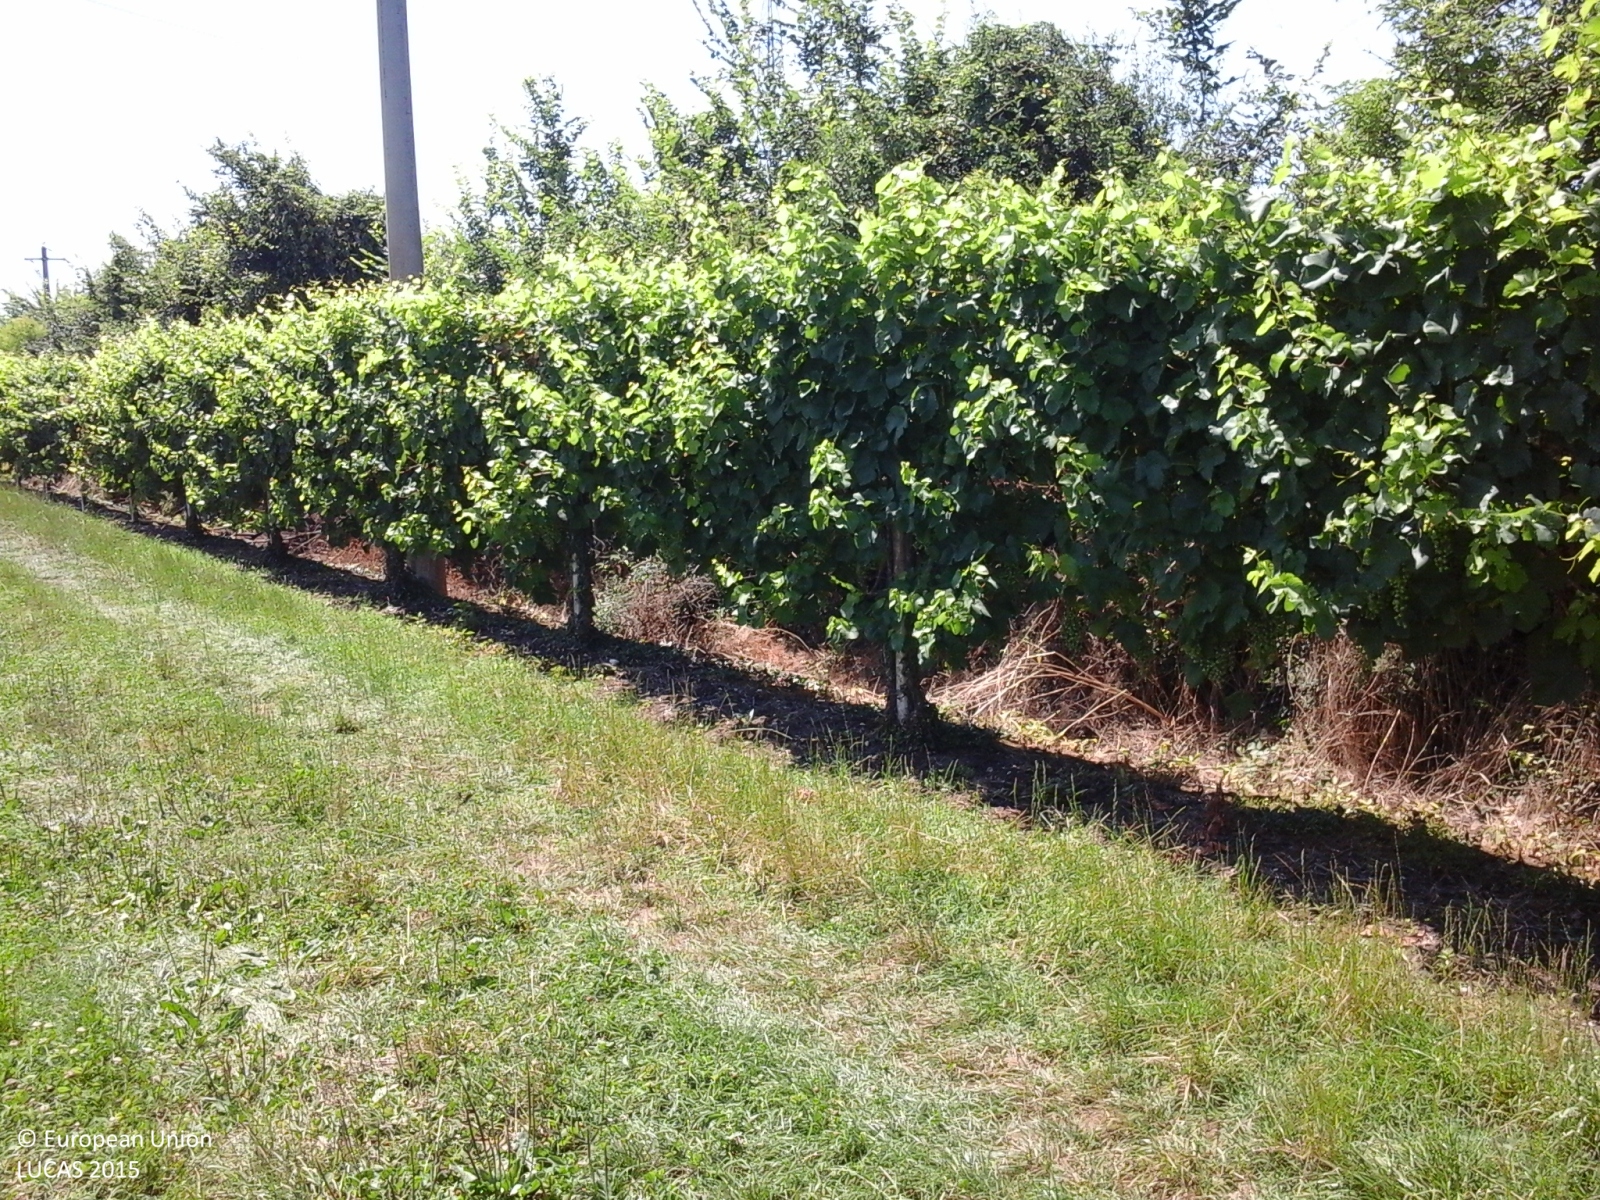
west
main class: Cropland
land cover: Vineyards
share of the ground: 25 - 50 %
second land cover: Grassland without tree/shrub cover
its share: > 75 %
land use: Agriculture (excluding fallow land and kitchen gardens)
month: July
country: IT
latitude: 45.8027
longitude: 12.3513
